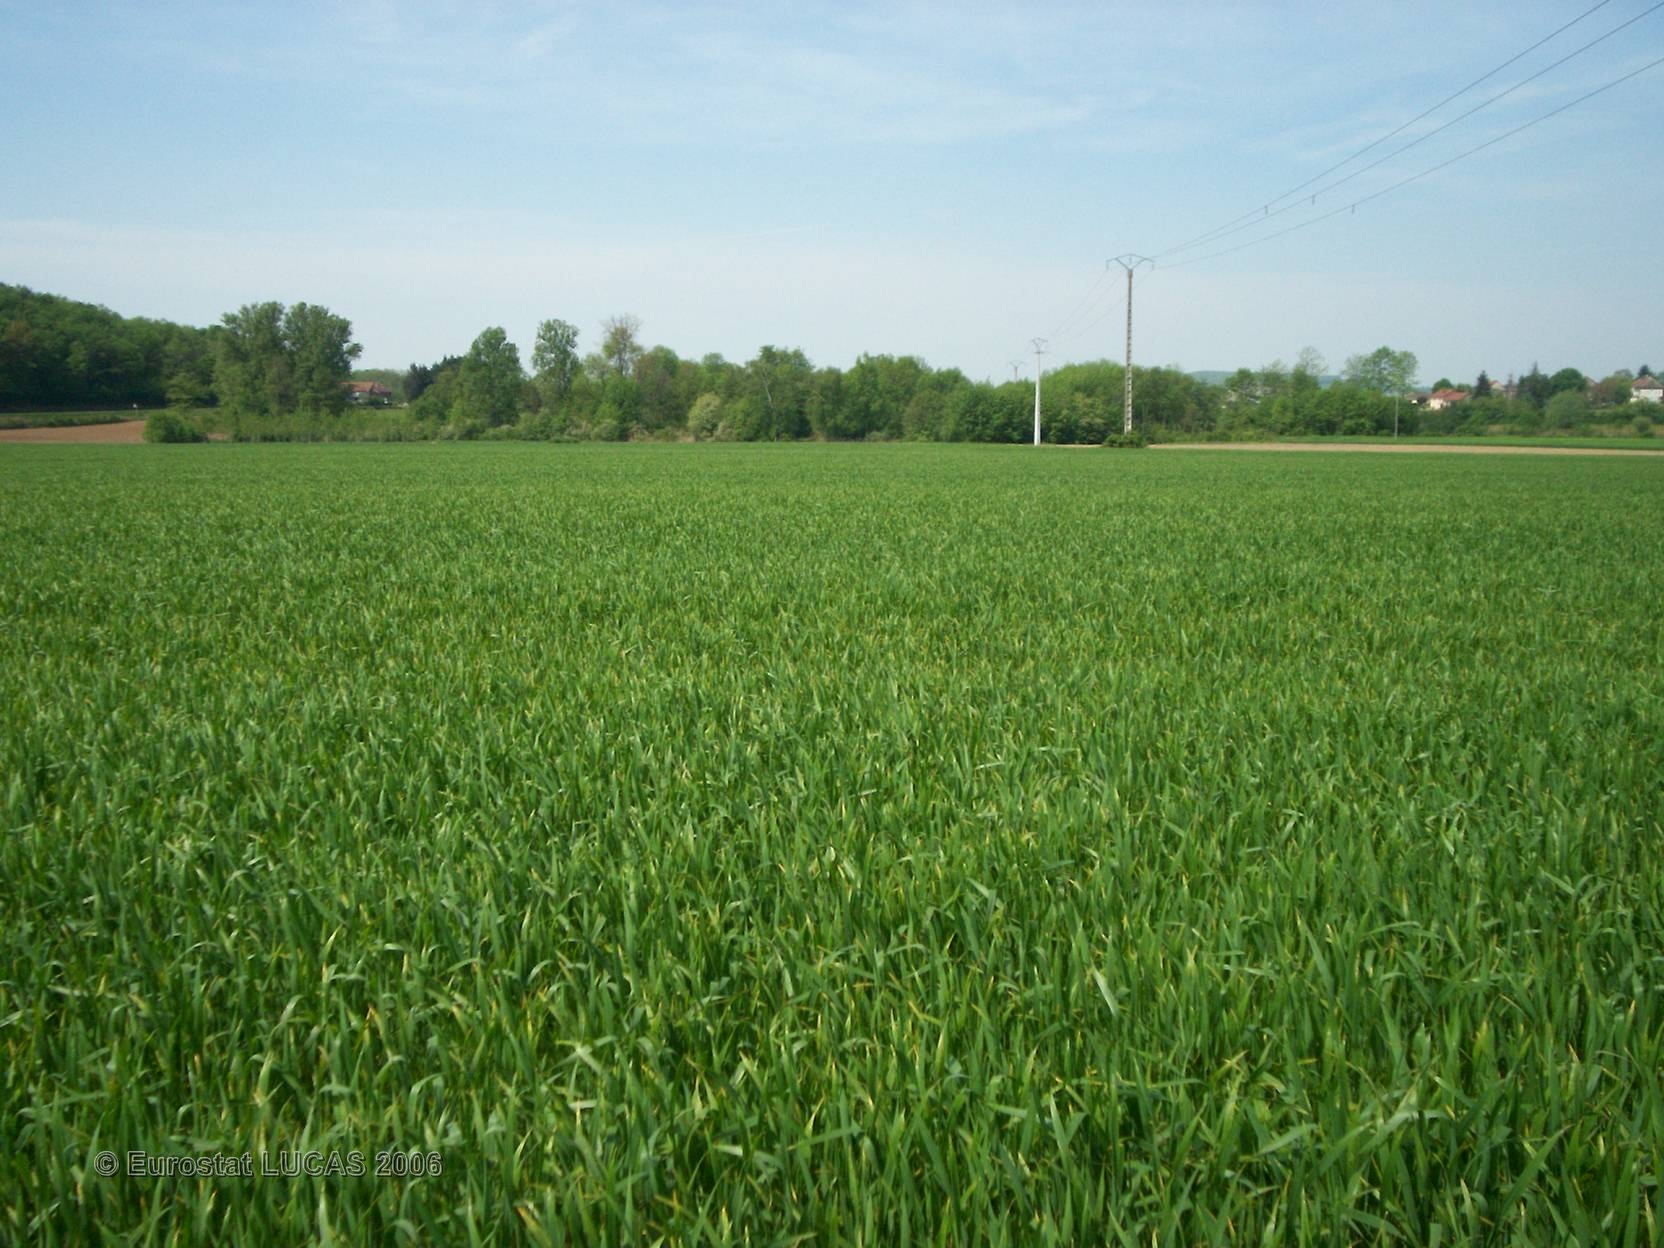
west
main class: Cropland
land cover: Common wheat
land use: Agriculture (excluding fallow land and kitchen gardens)
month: May
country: FR
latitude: 45.6938
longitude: 5.4197
